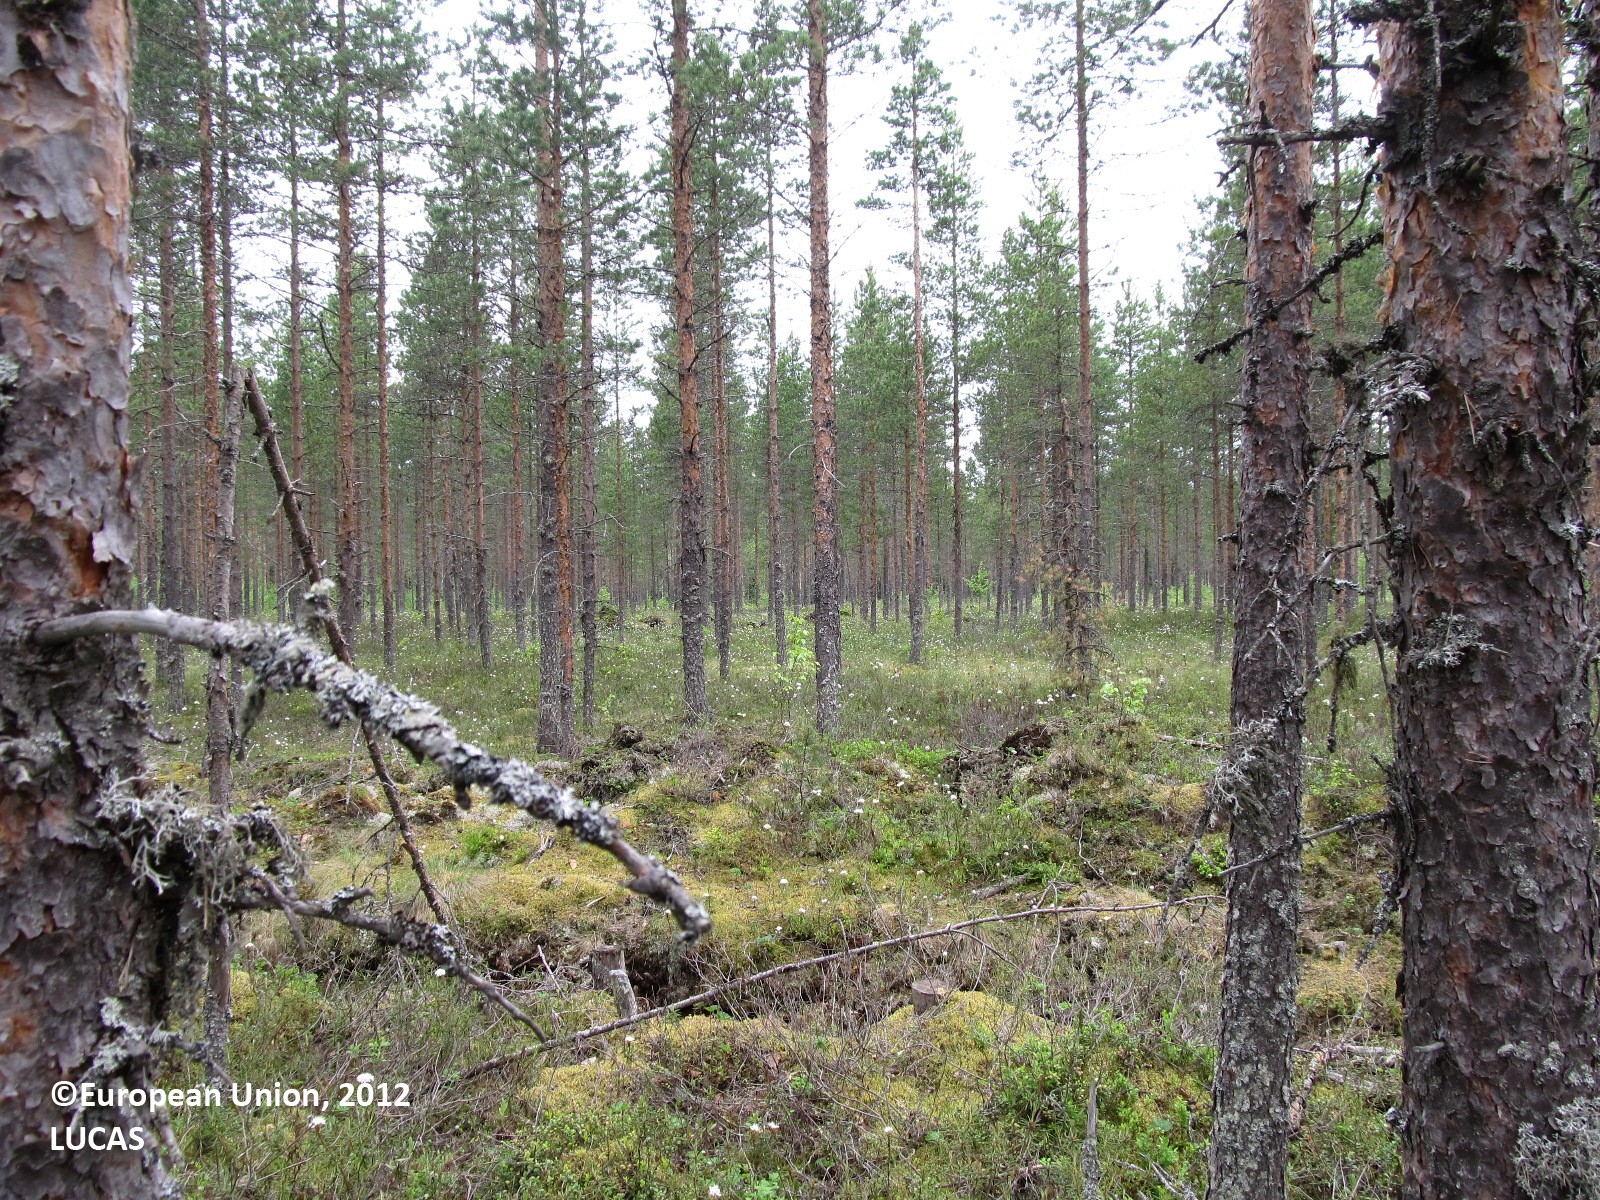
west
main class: Woodland
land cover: Pine dominated coniferous woodland
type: boreal forest
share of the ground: 25 - 50 %
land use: Forestry
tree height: > 5 m
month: June
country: FI
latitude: 63.3010
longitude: 27.8237
